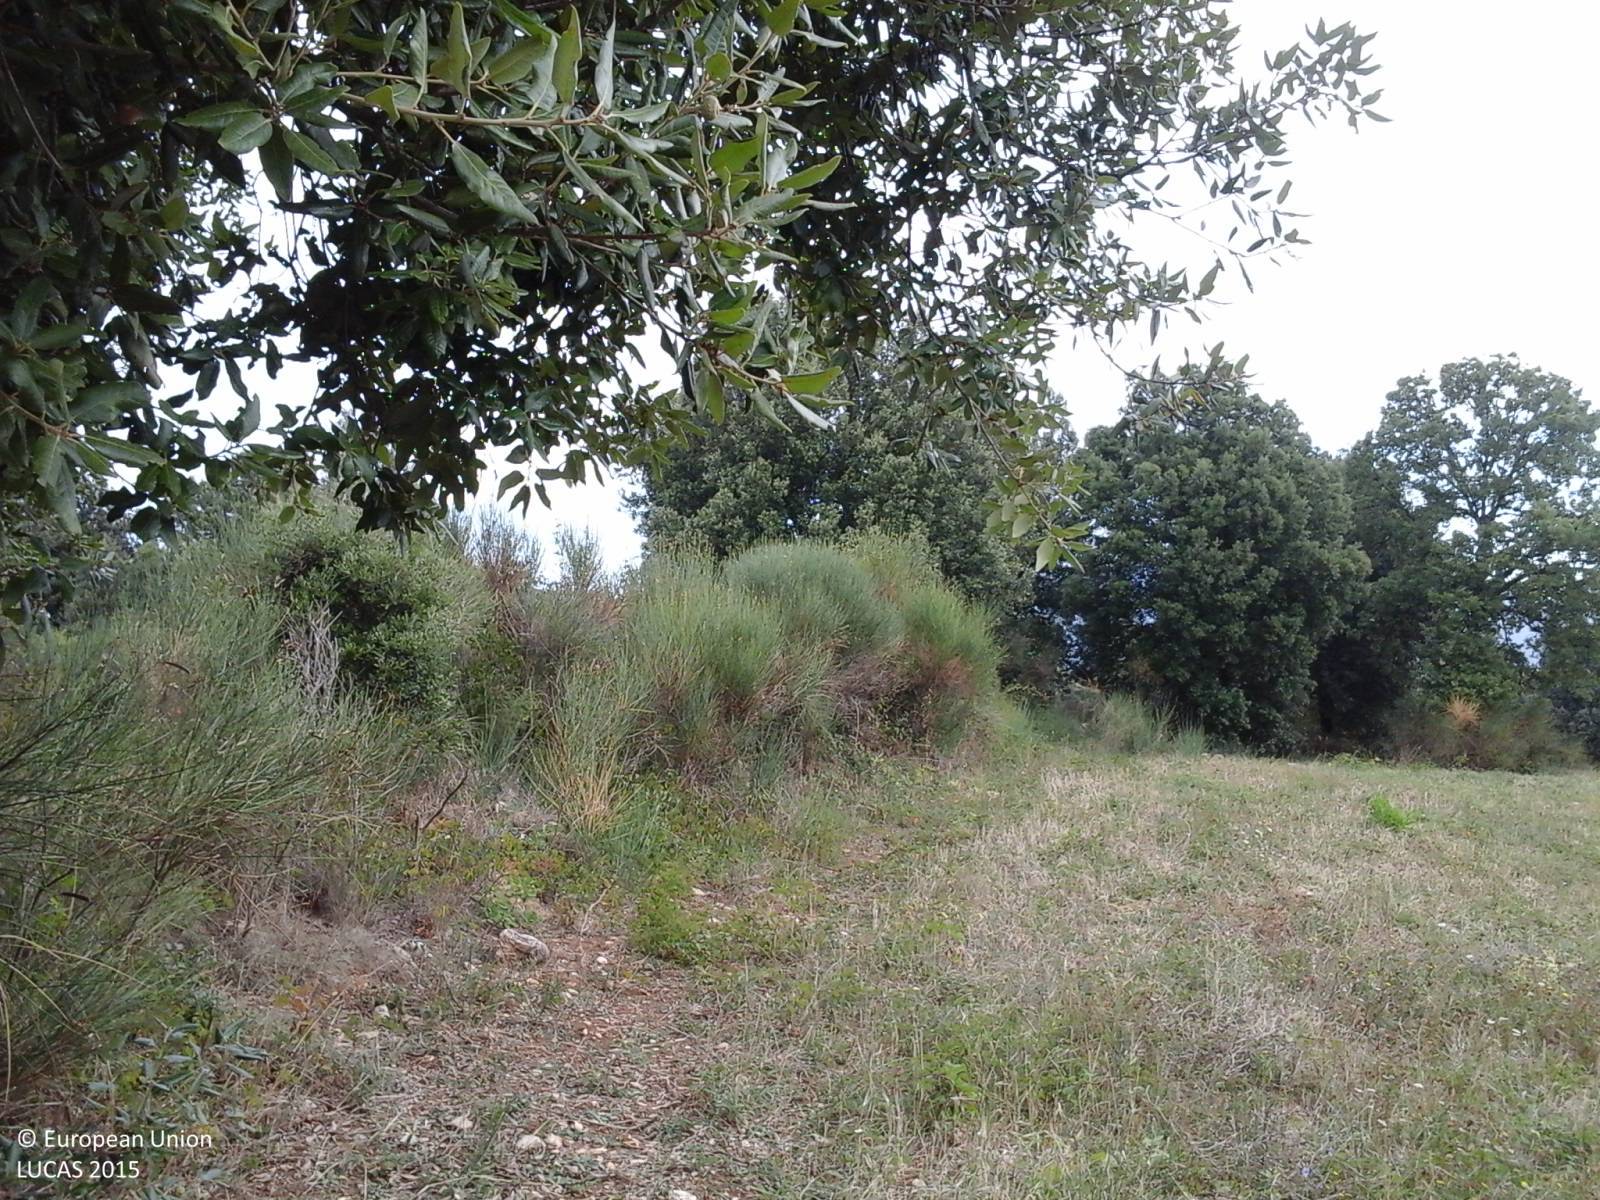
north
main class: Grassland
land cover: Grassland without tree/shrub cover
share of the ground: > 75 %
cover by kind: herbaceous plants 100 %
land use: Agriculture (excluding fallow land and kitchen gardens)
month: September
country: IT
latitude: 43.1333
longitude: 12.3167
